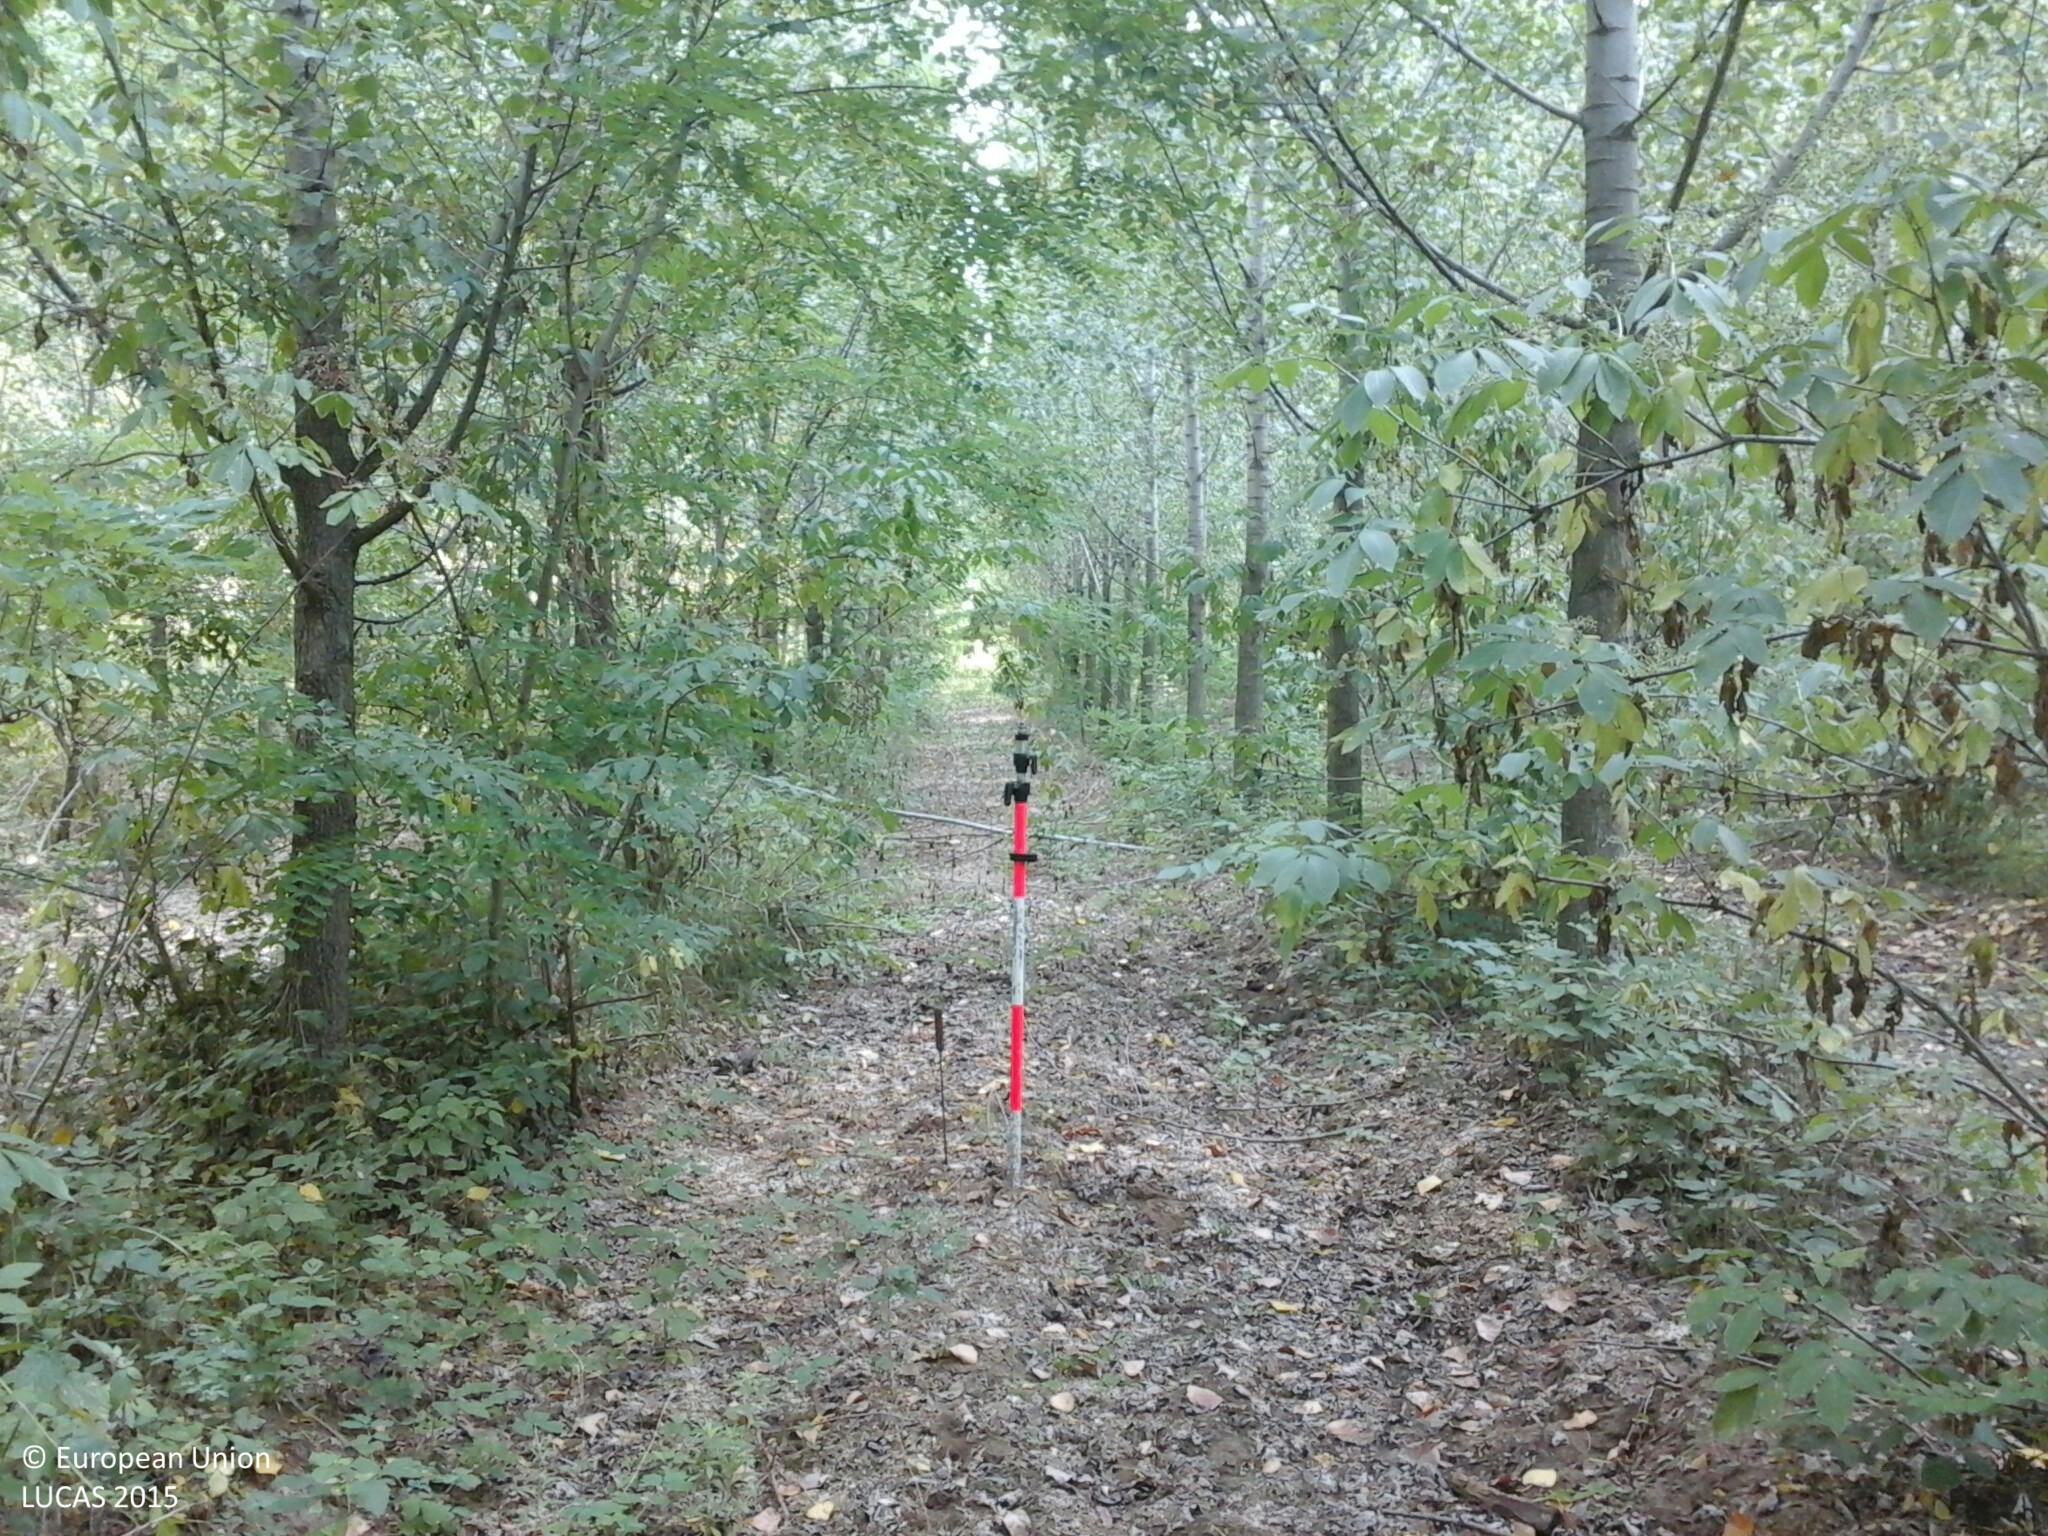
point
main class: Woodland
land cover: Broadleaved woodland
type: floodplain forest
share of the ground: > 75 %
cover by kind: broadleaved forest trees 100 %
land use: Forestry
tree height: > 5 m
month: July
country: HU
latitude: 48.3923
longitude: 22.2526
